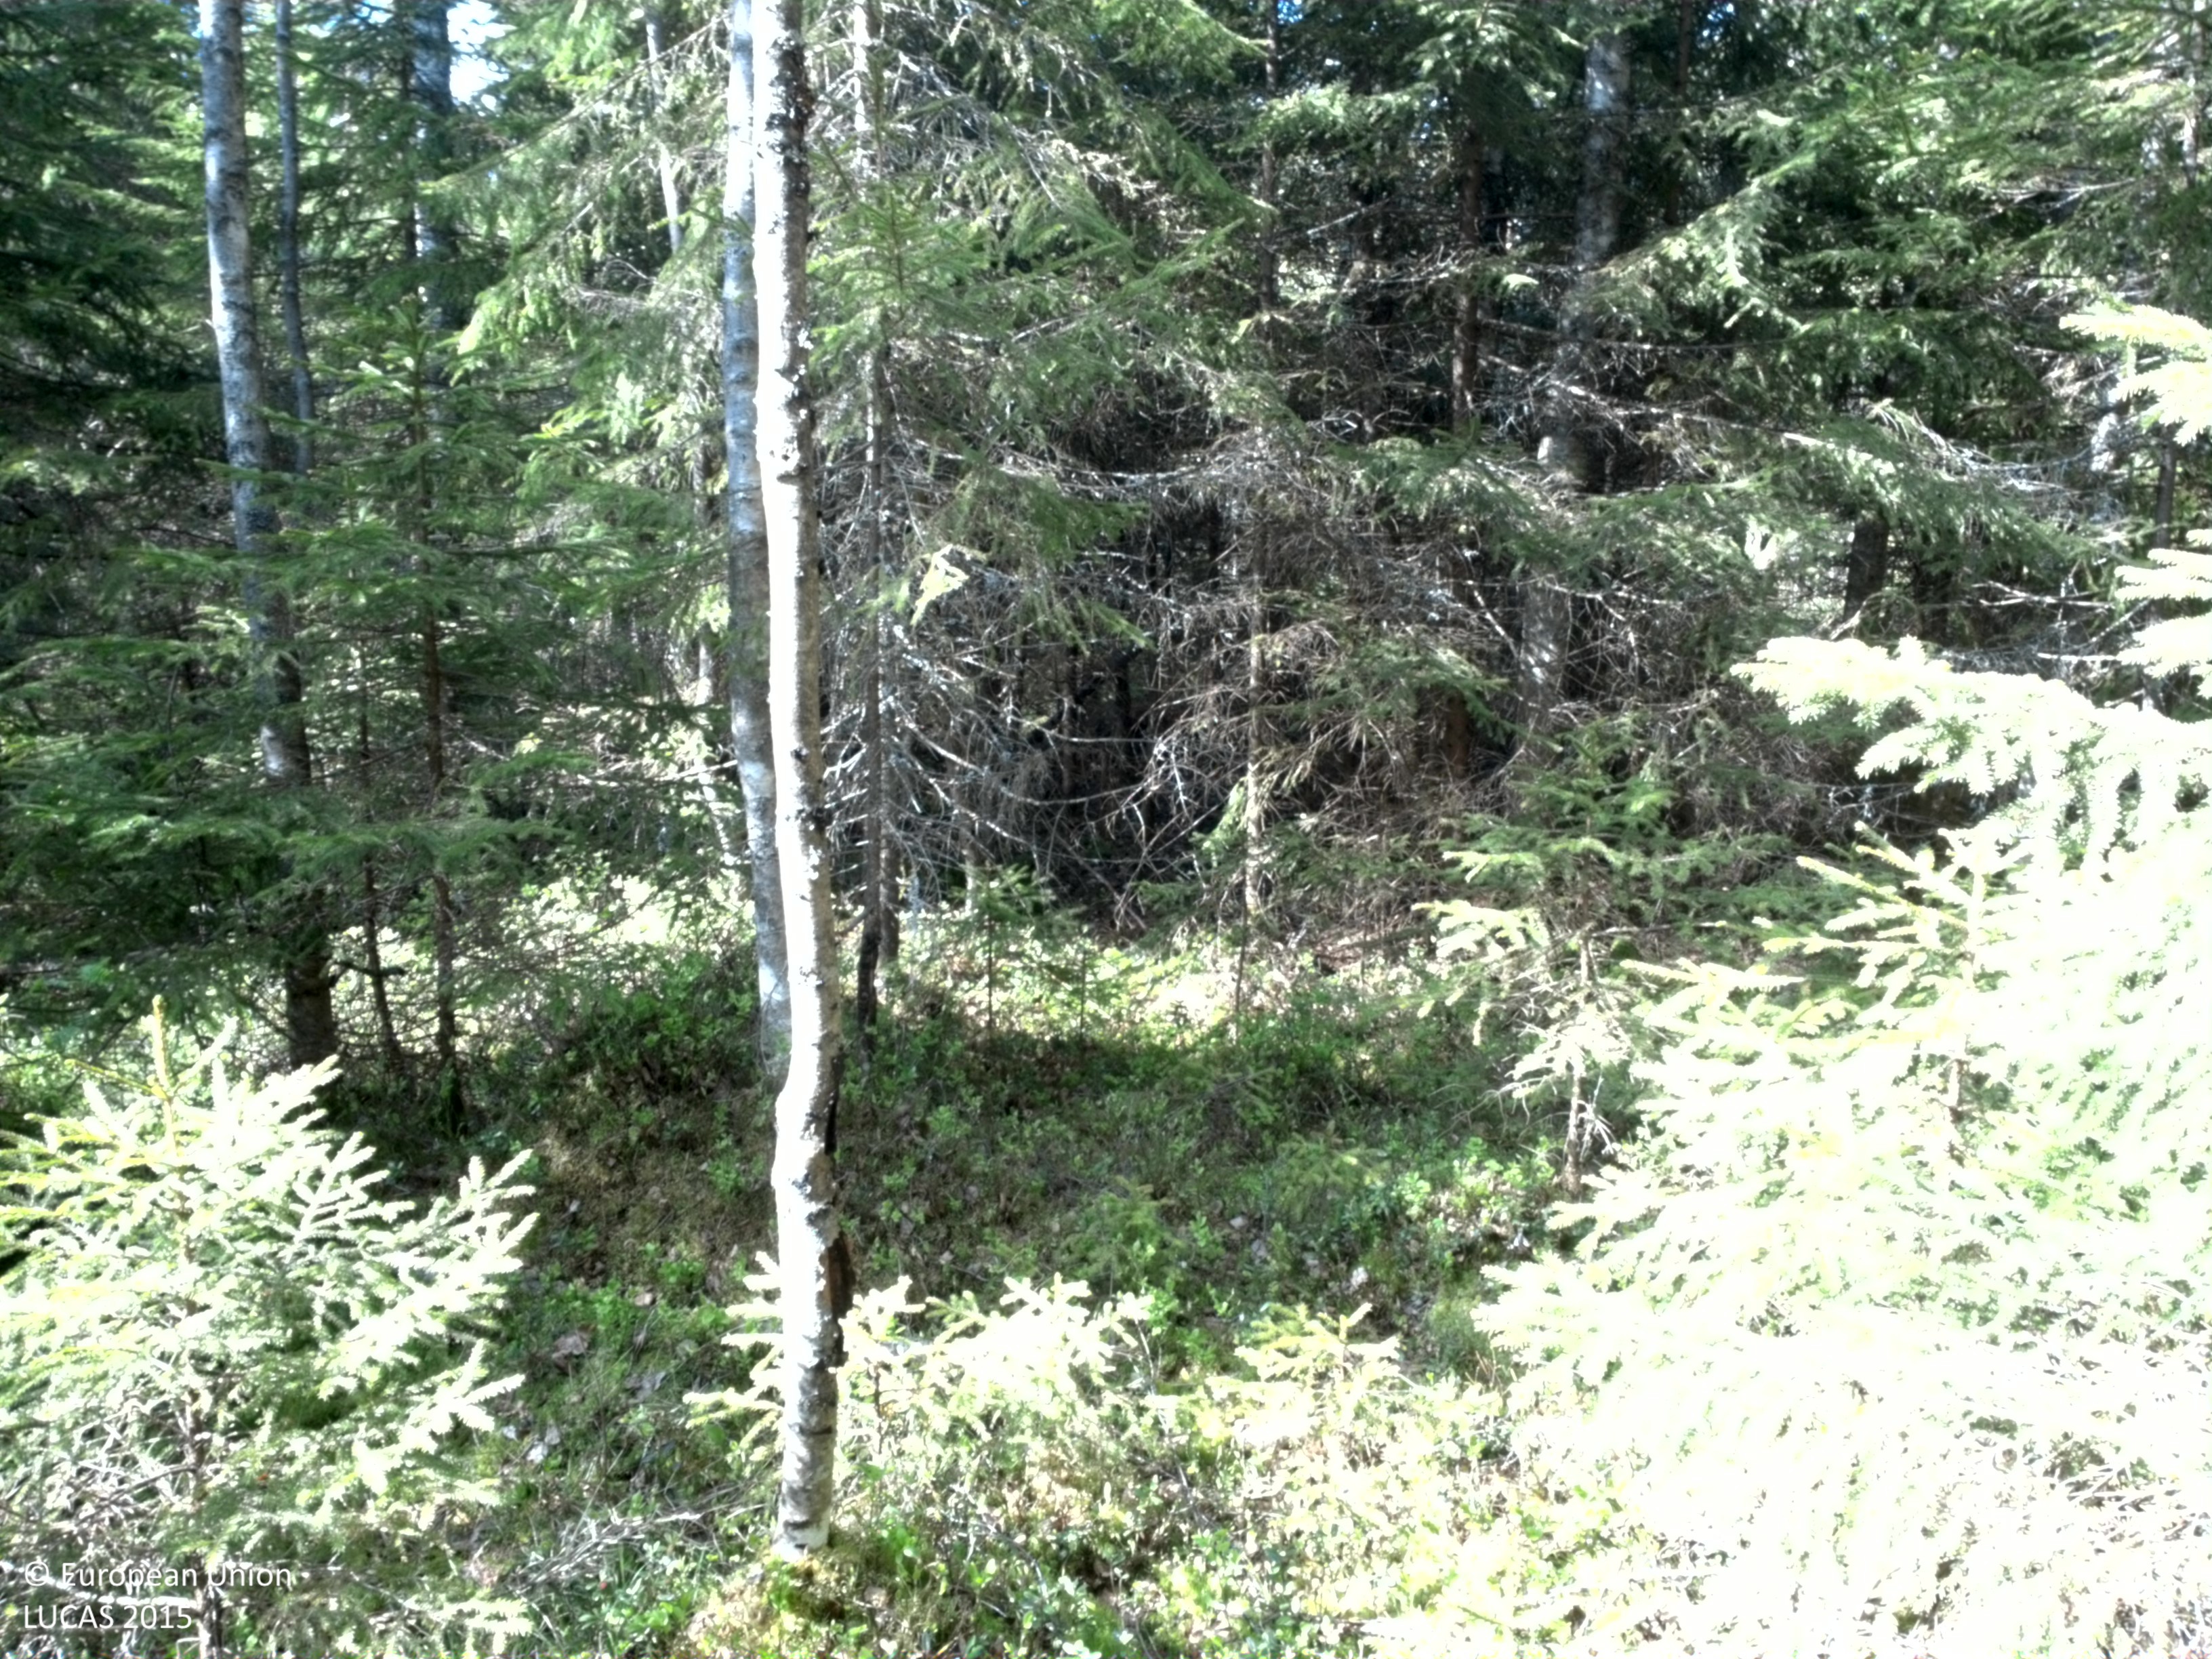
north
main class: Woodland
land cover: Spruce dominated mixed woodland
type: boreal forest
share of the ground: > 75 %
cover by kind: coniferous forest trees 75 %, broadleaved forest trees 25 %
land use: Forestry
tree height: > 5 m
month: May
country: SE
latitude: 56.5421
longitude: 15.4145
